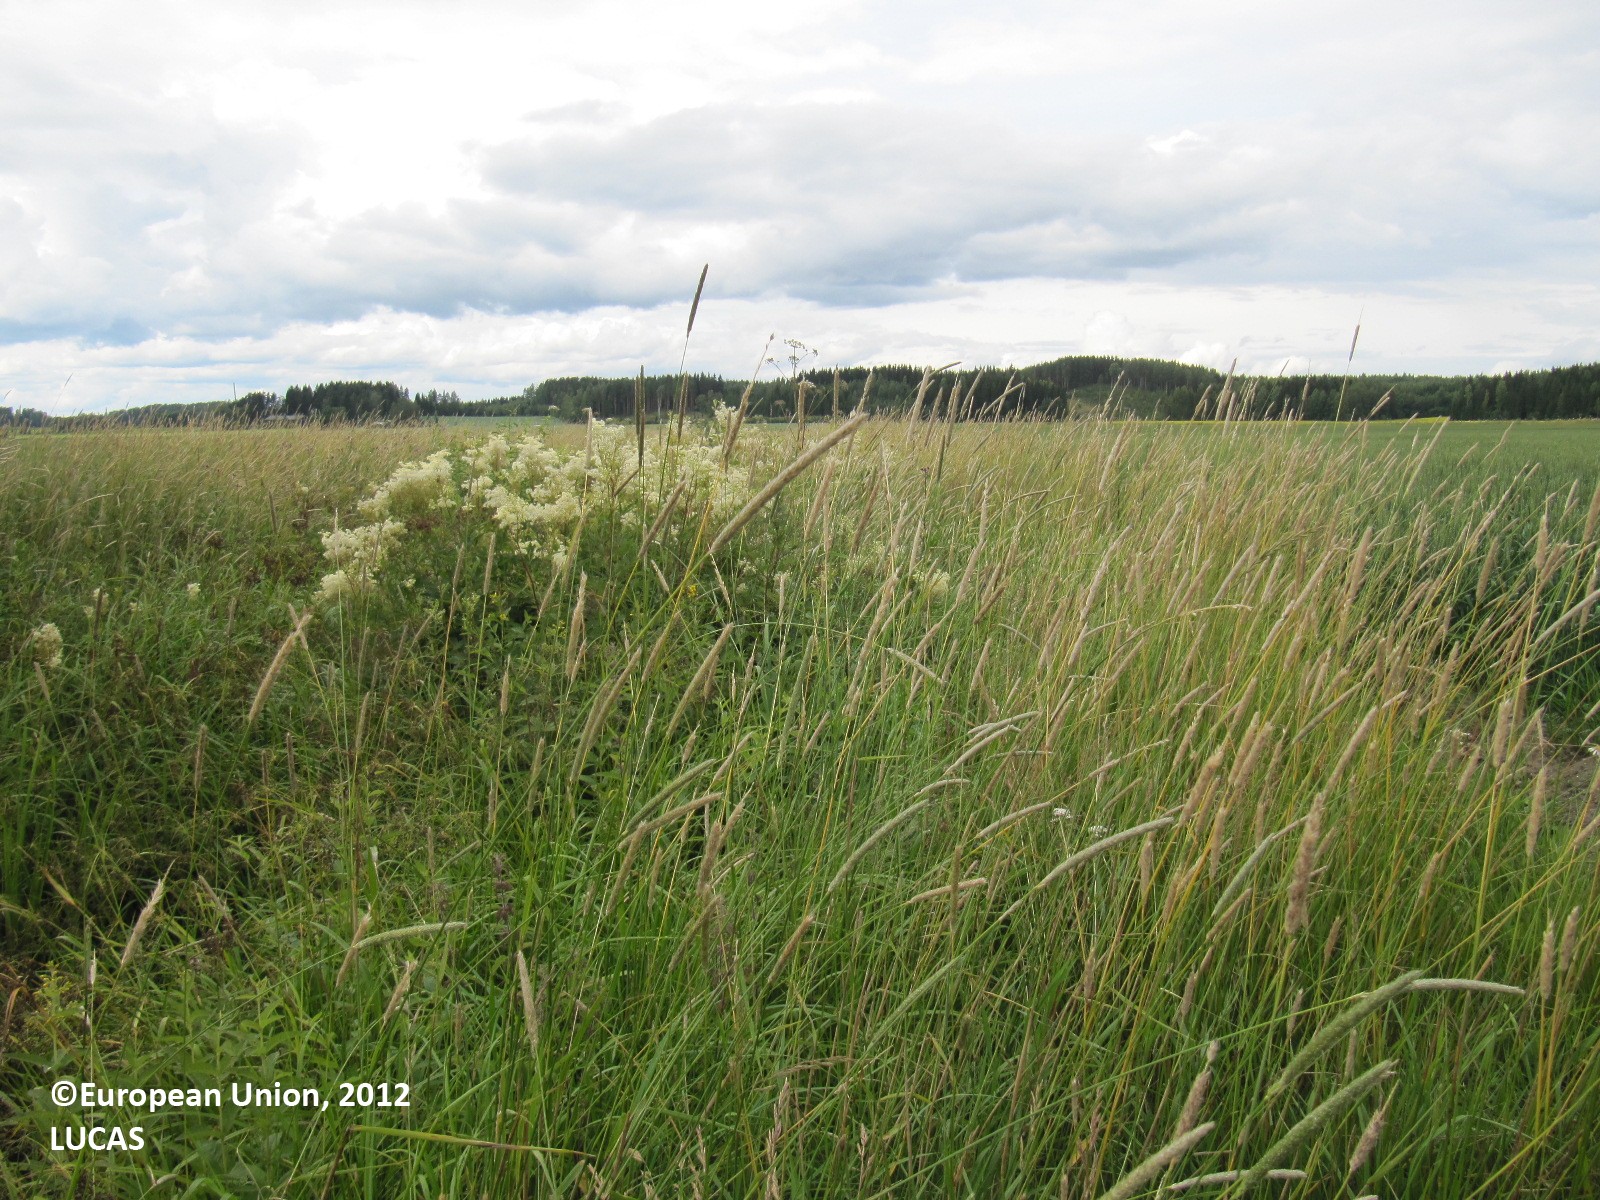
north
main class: Grassland
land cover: Spontaneously vegetated surfaces
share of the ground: > 75 %
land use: Semi-natural and natural areas not in use
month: July
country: FI
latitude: 60.8235
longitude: 24.6528
